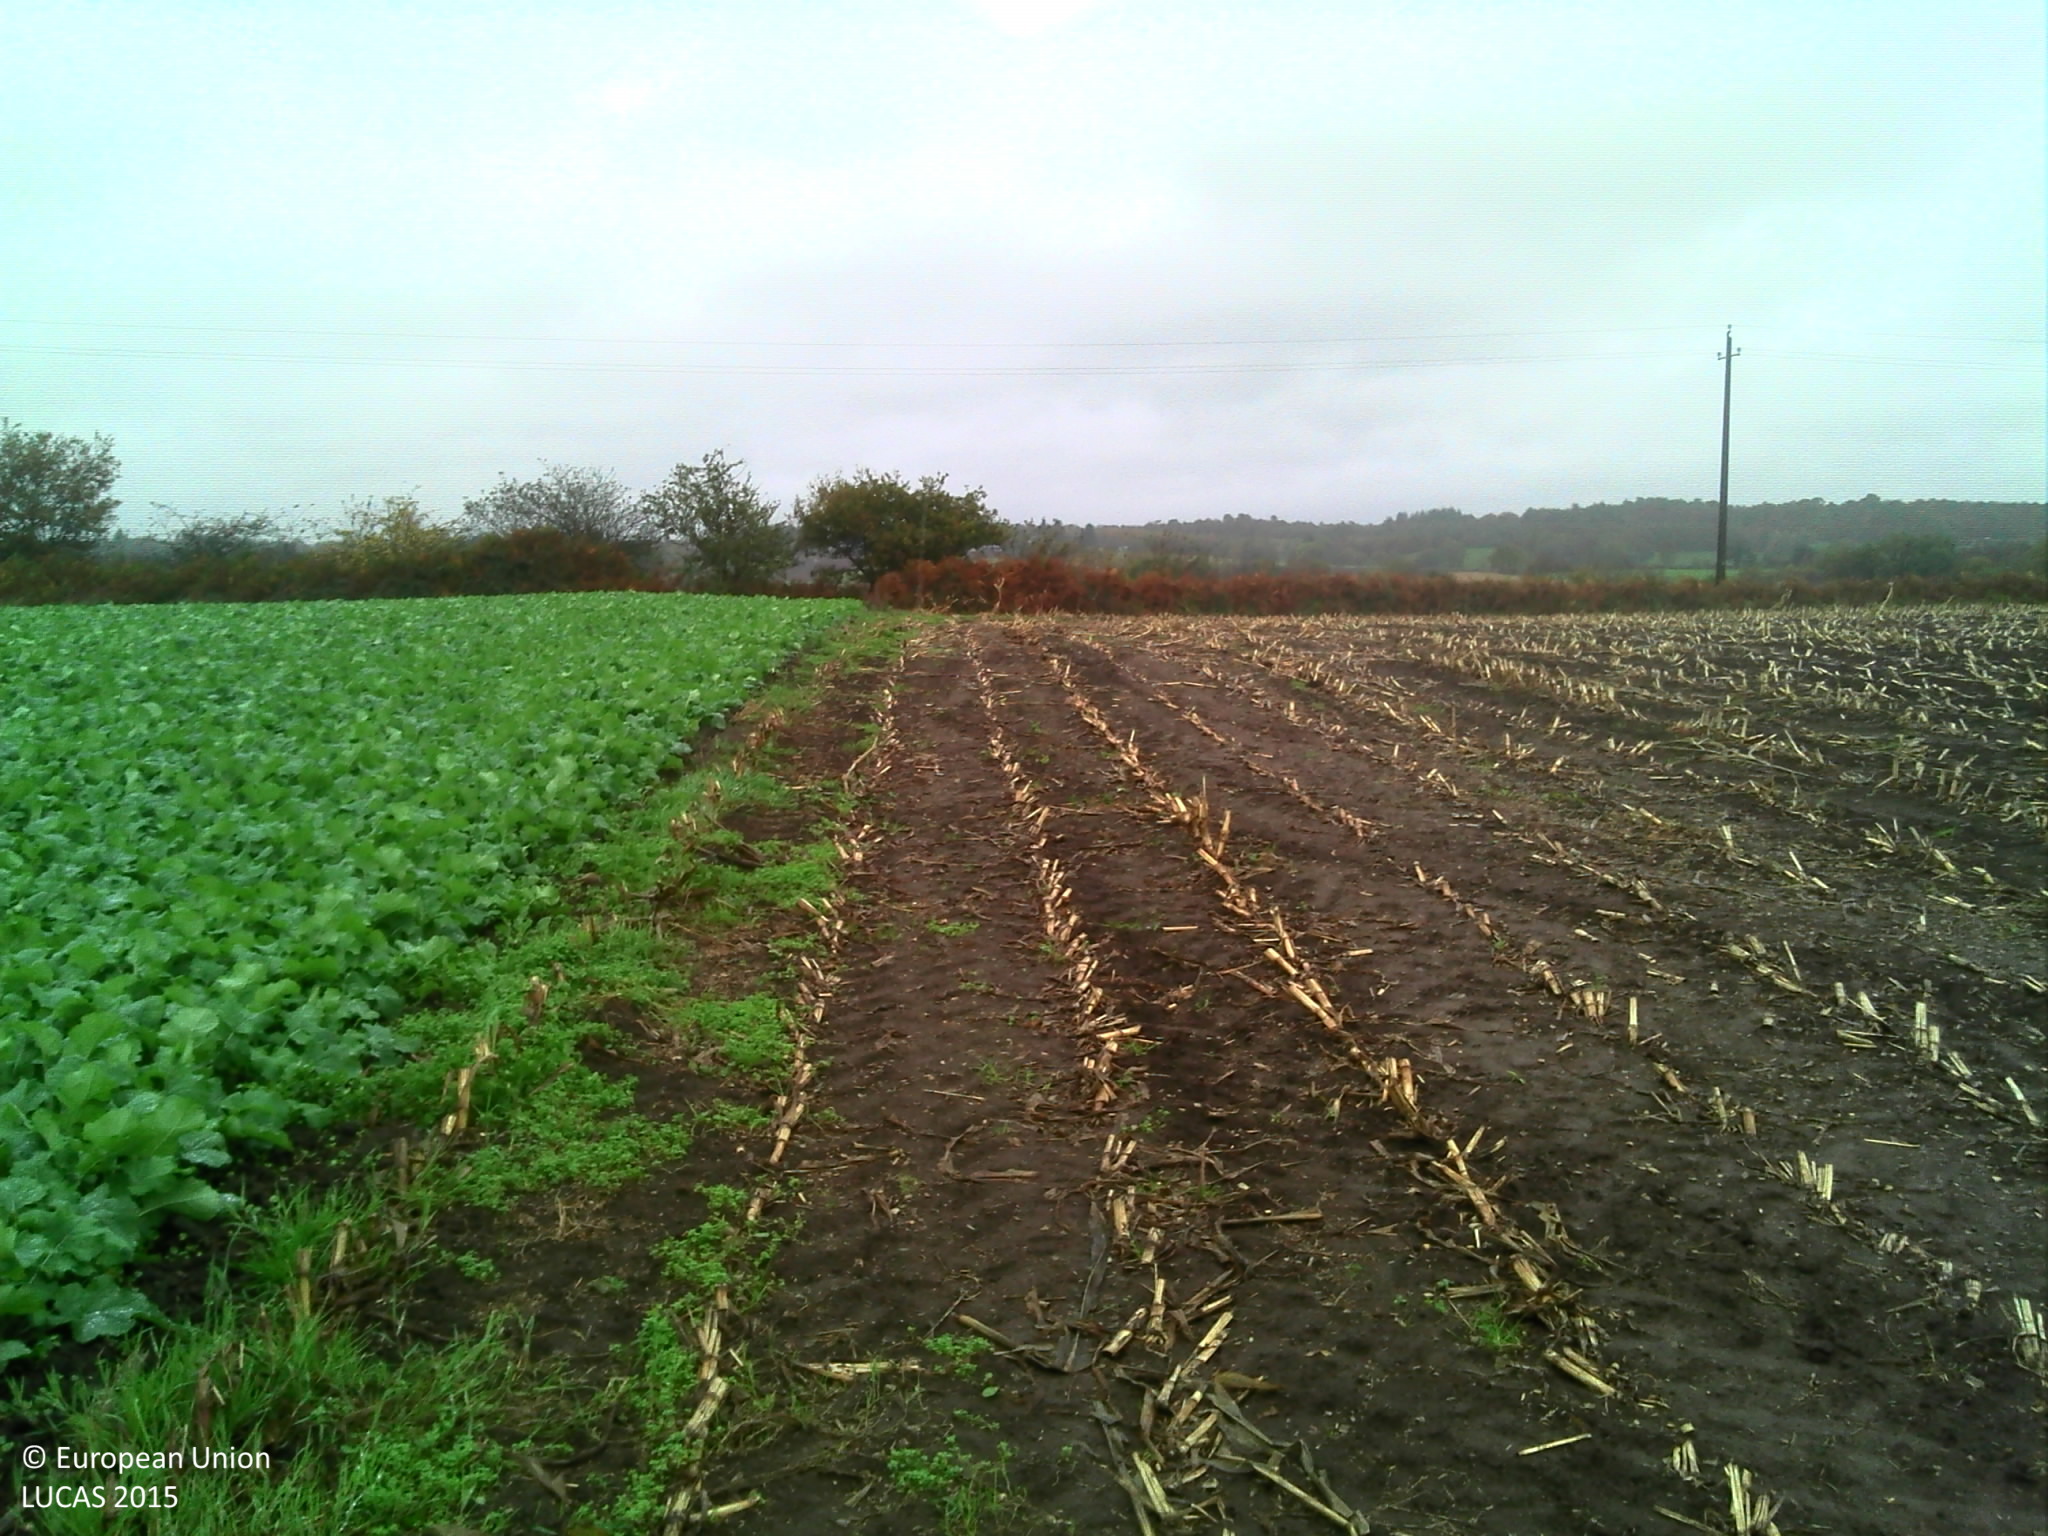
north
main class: Cropland
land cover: Rape and turnip rape
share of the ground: > 75 %
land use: Agriculture (excluding fallow land and kitchen gardens)
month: November
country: FR
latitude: 47.9502
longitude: -3.2336
